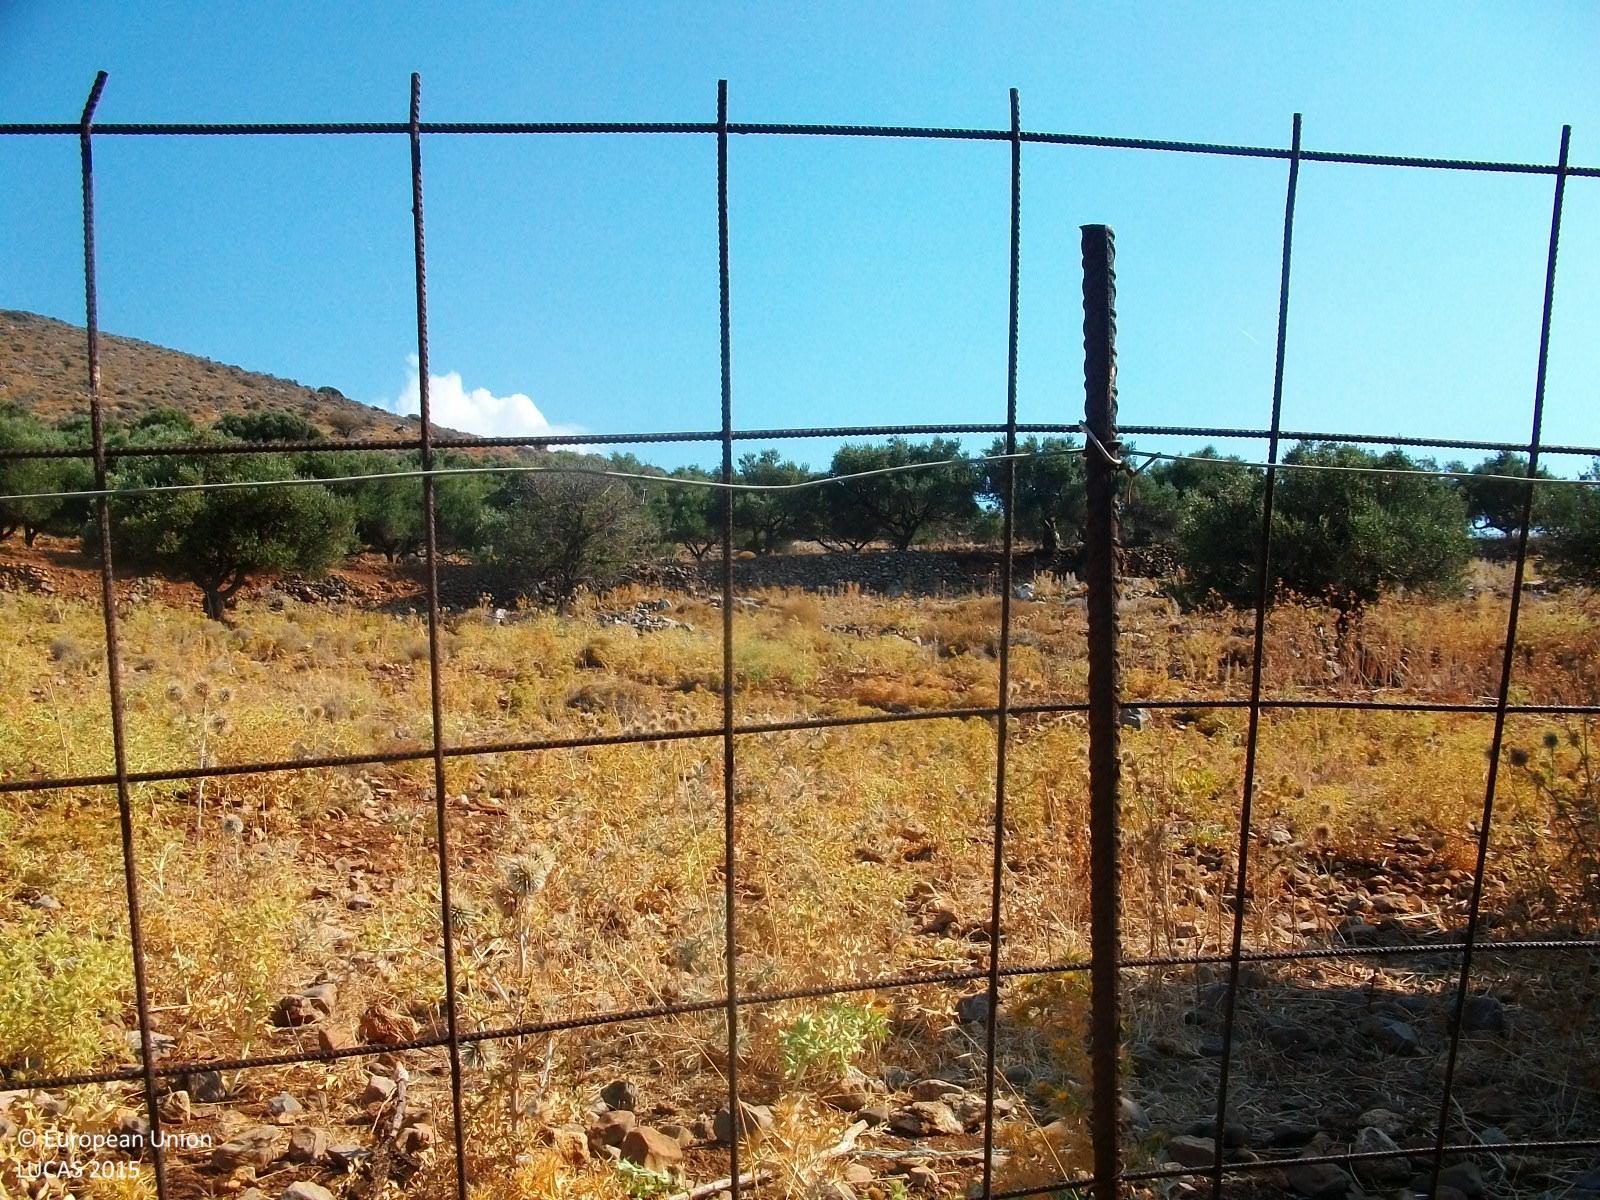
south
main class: Shrubland
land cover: Shrubland without tree cover
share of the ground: > 75 %
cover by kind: shrubs 100 %
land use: Semi-natural and natural areas not in use
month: August
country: GR
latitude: 35.3214
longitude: 25.6298
